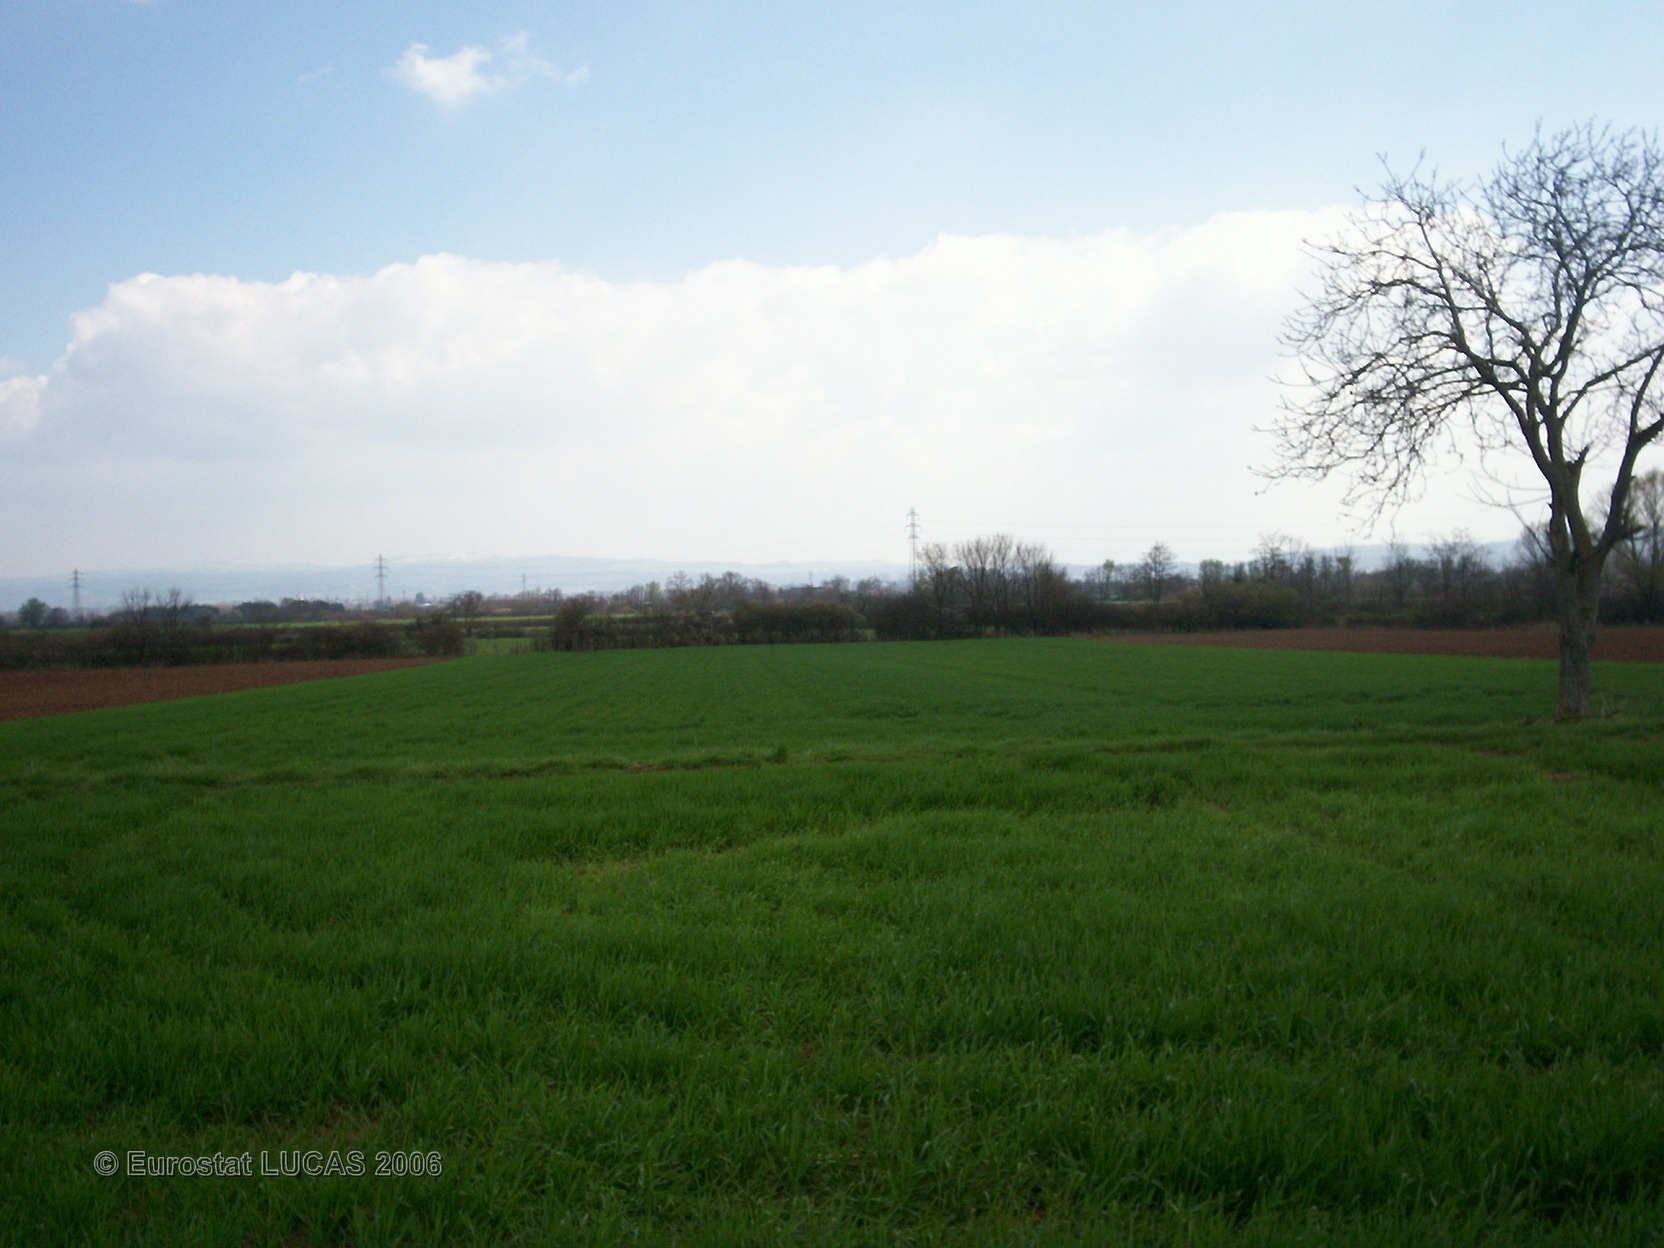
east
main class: Cropland
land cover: Common wheat
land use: Agriculture (excluding fallow land and kitchen gardens)
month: April
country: FR
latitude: 45.5437
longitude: 4.2014
